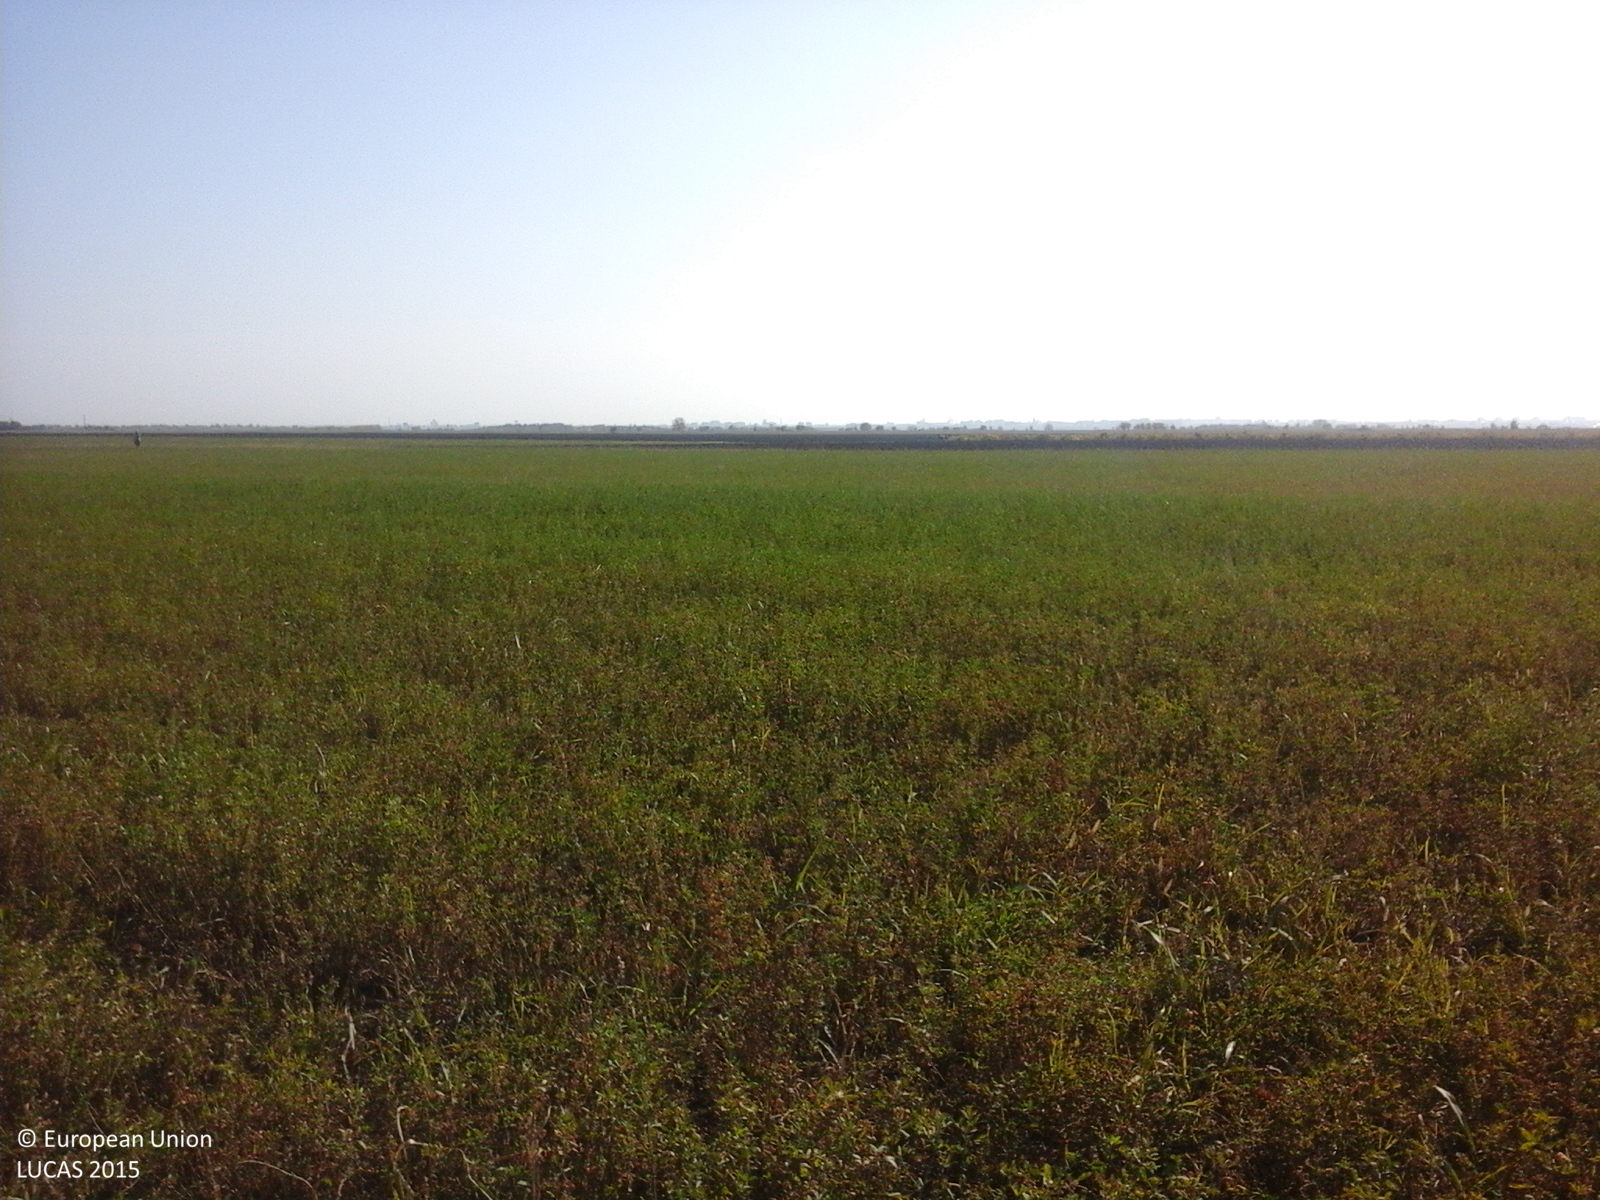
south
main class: Cropland
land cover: Lucerne
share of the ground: > 75 %
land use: Agriculture (excluding fallow land and kitchen gardens)
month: October
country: RO
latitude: 45.2086
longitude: 26.8232
